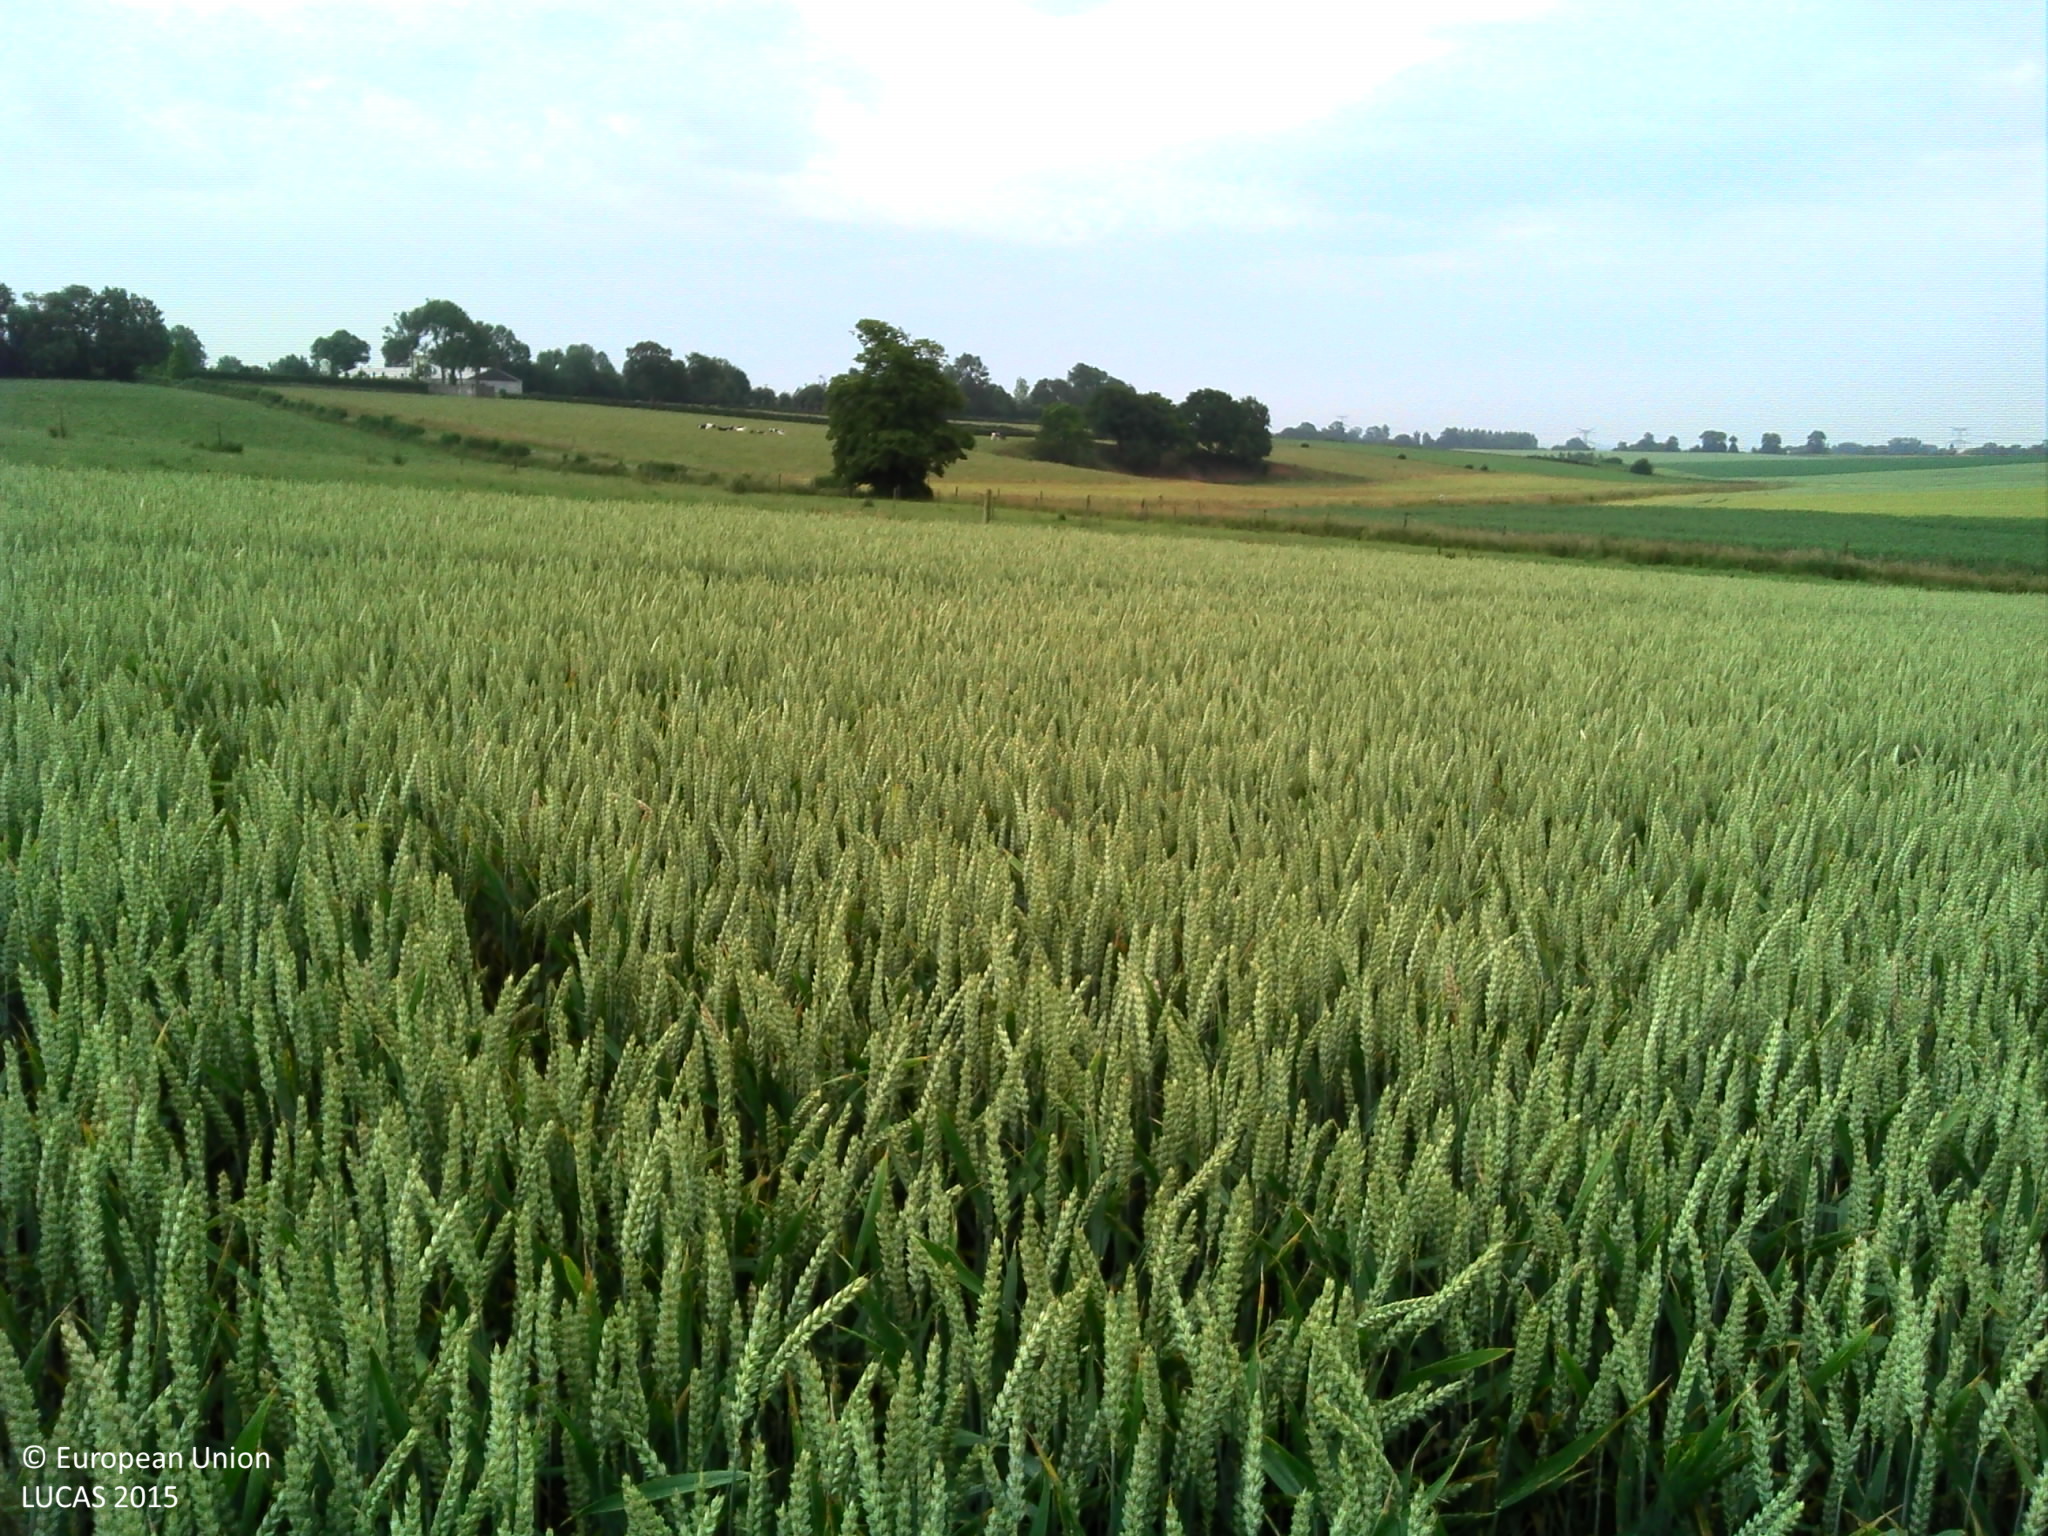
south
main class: Cropland
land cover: Common wheat
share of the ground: > 75 %
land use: Agriculture (excluding fallow land and kitchen gardens)
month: July
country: FR
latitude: 50.4547
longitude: 2.1400
